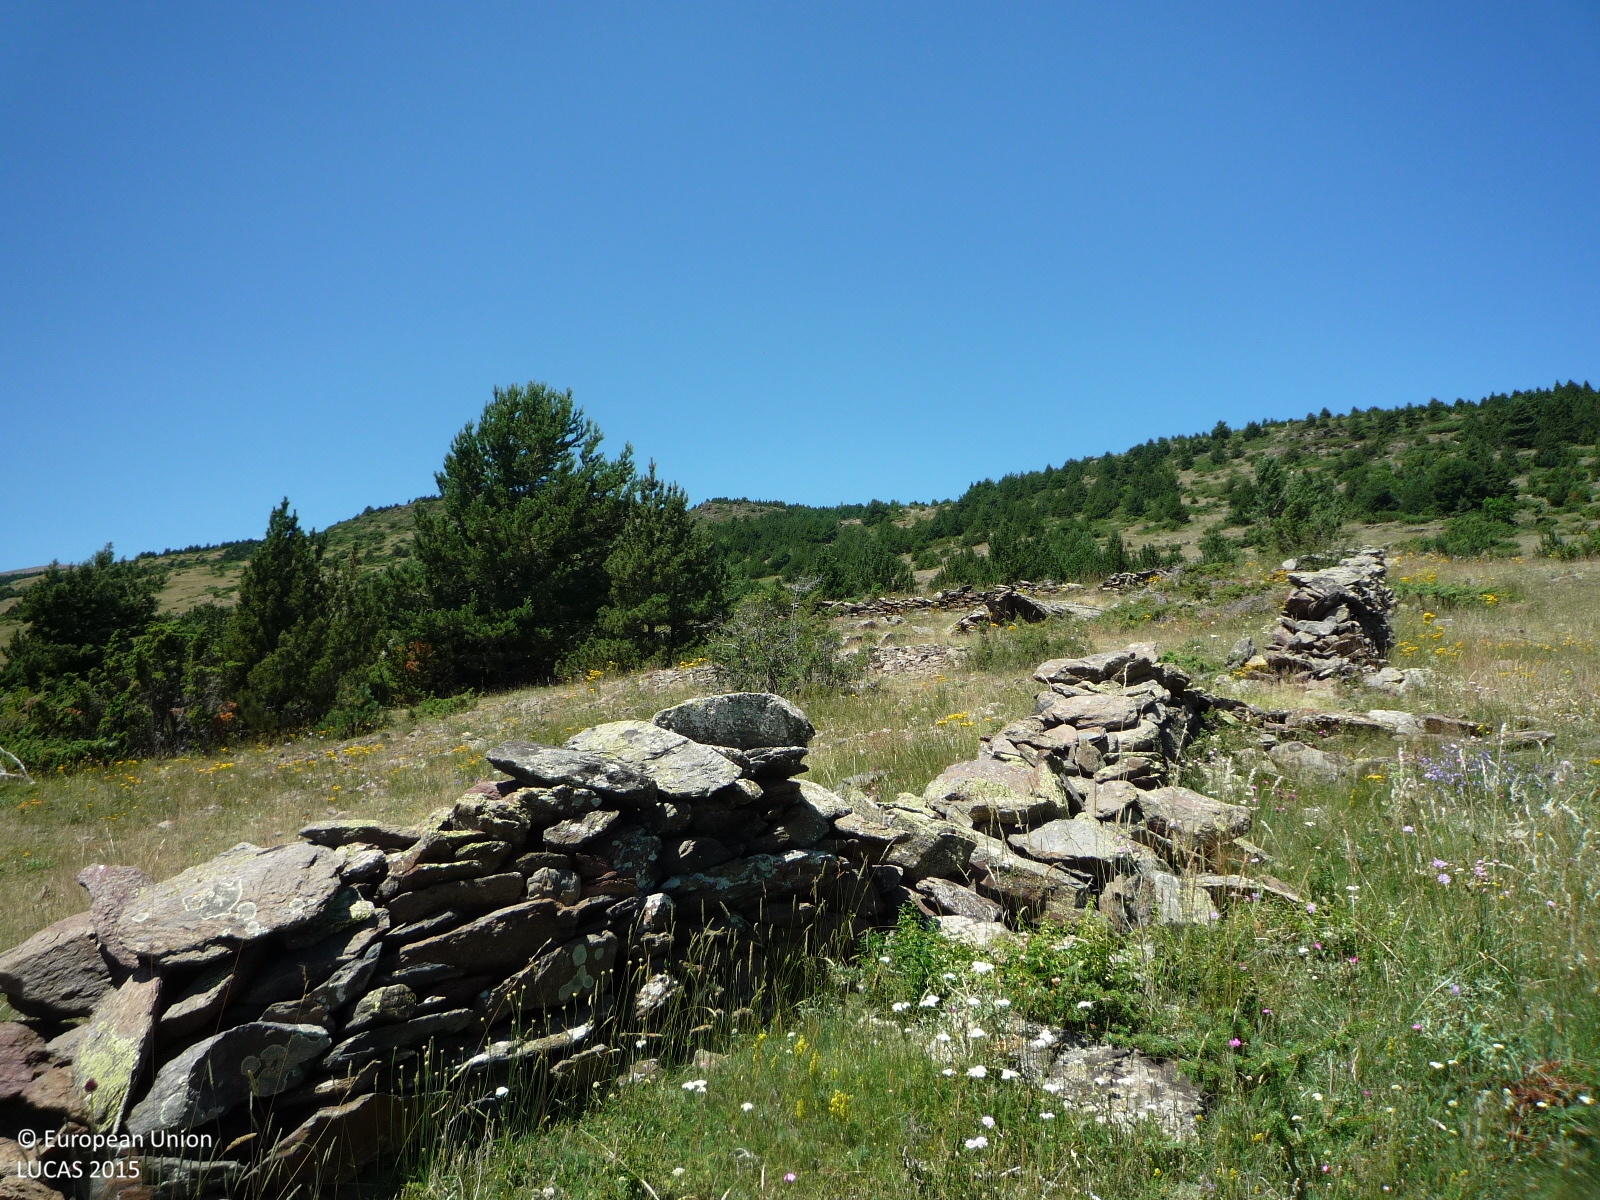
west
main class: Grassland
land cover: Grassland with sparse tree/shrub cover
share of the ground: > 75 %
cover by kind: herbaceous plants 95 %, coniferous forest trees 5 %
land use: Agriculture (excluding fallow land and kitchen gardens)
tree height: < 5 m
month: July
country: ES
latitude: 42.4543
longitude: 1.8760
